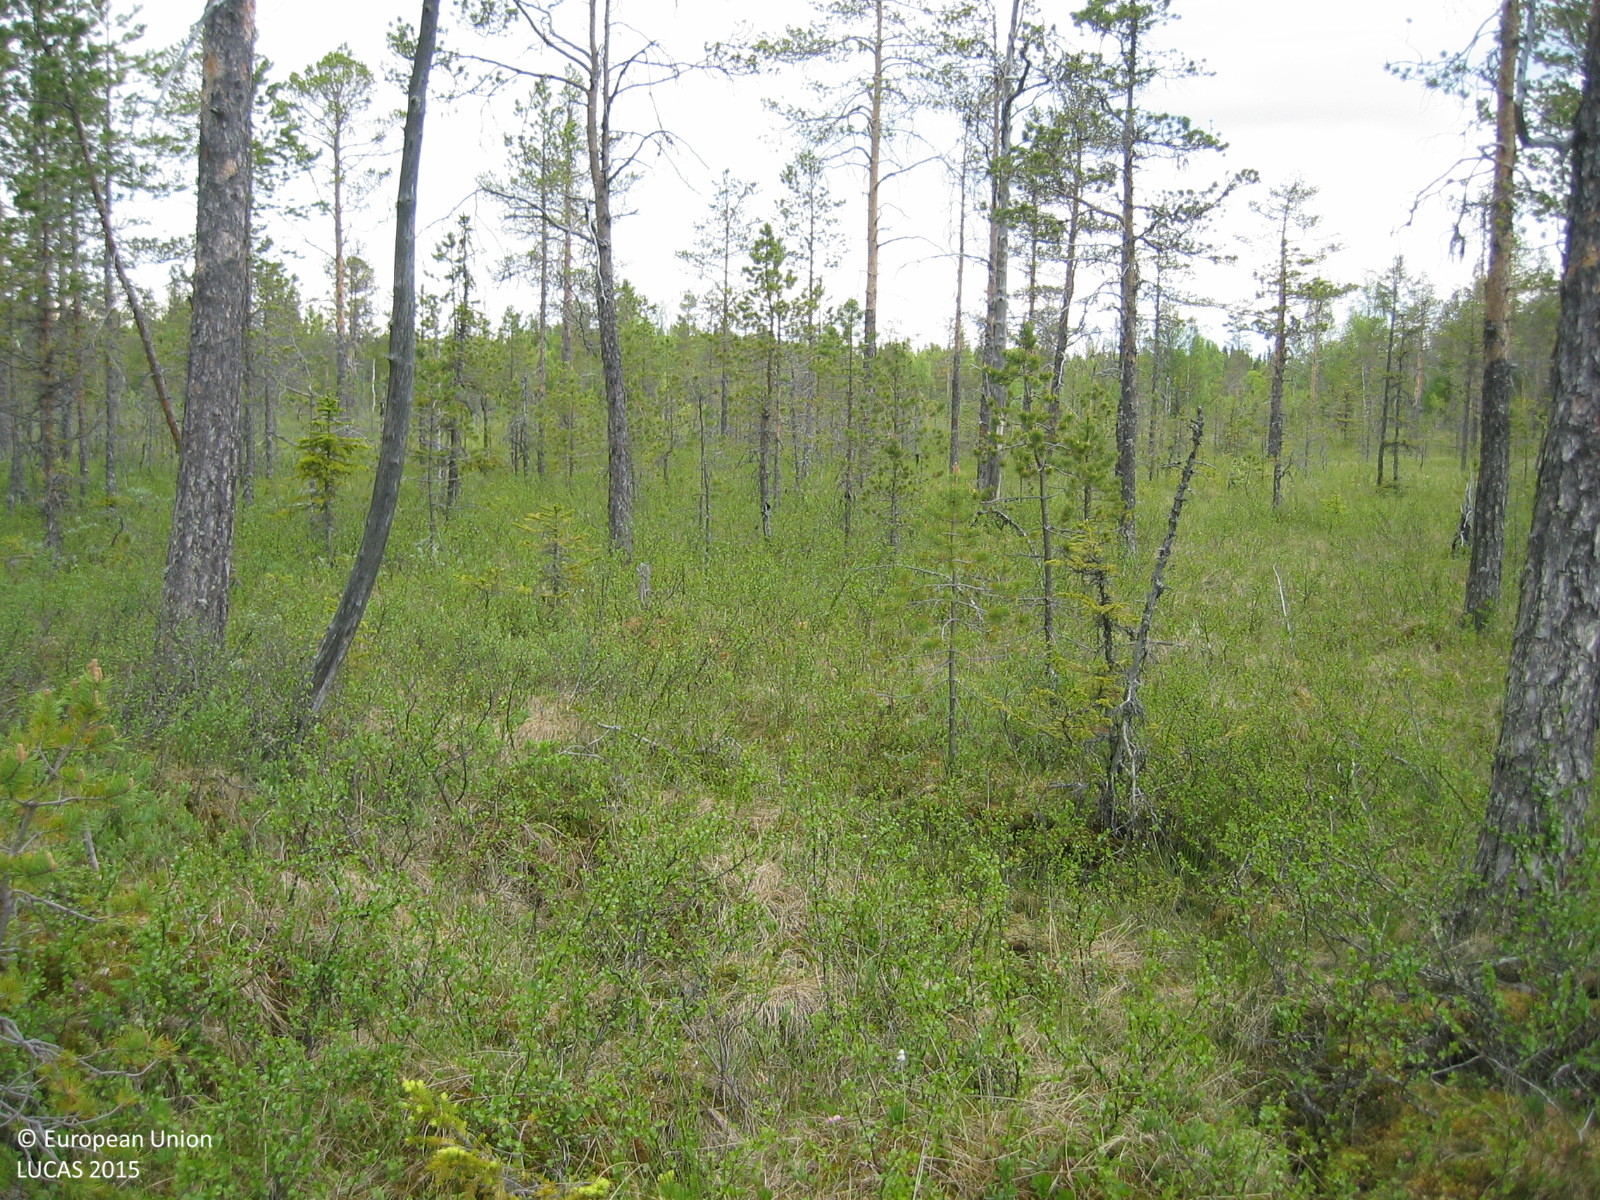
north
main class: Woodland
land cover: Pine dominated coniferous woodland
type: boreal forest
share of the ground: 50 - 75 %
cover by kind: coniferous forest trees 60 %, shrubs 40 %
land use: Semi-natural and natural areas not in use
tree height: > 5 m
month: June
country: SE
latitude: 63.5327
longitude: 14.7031
